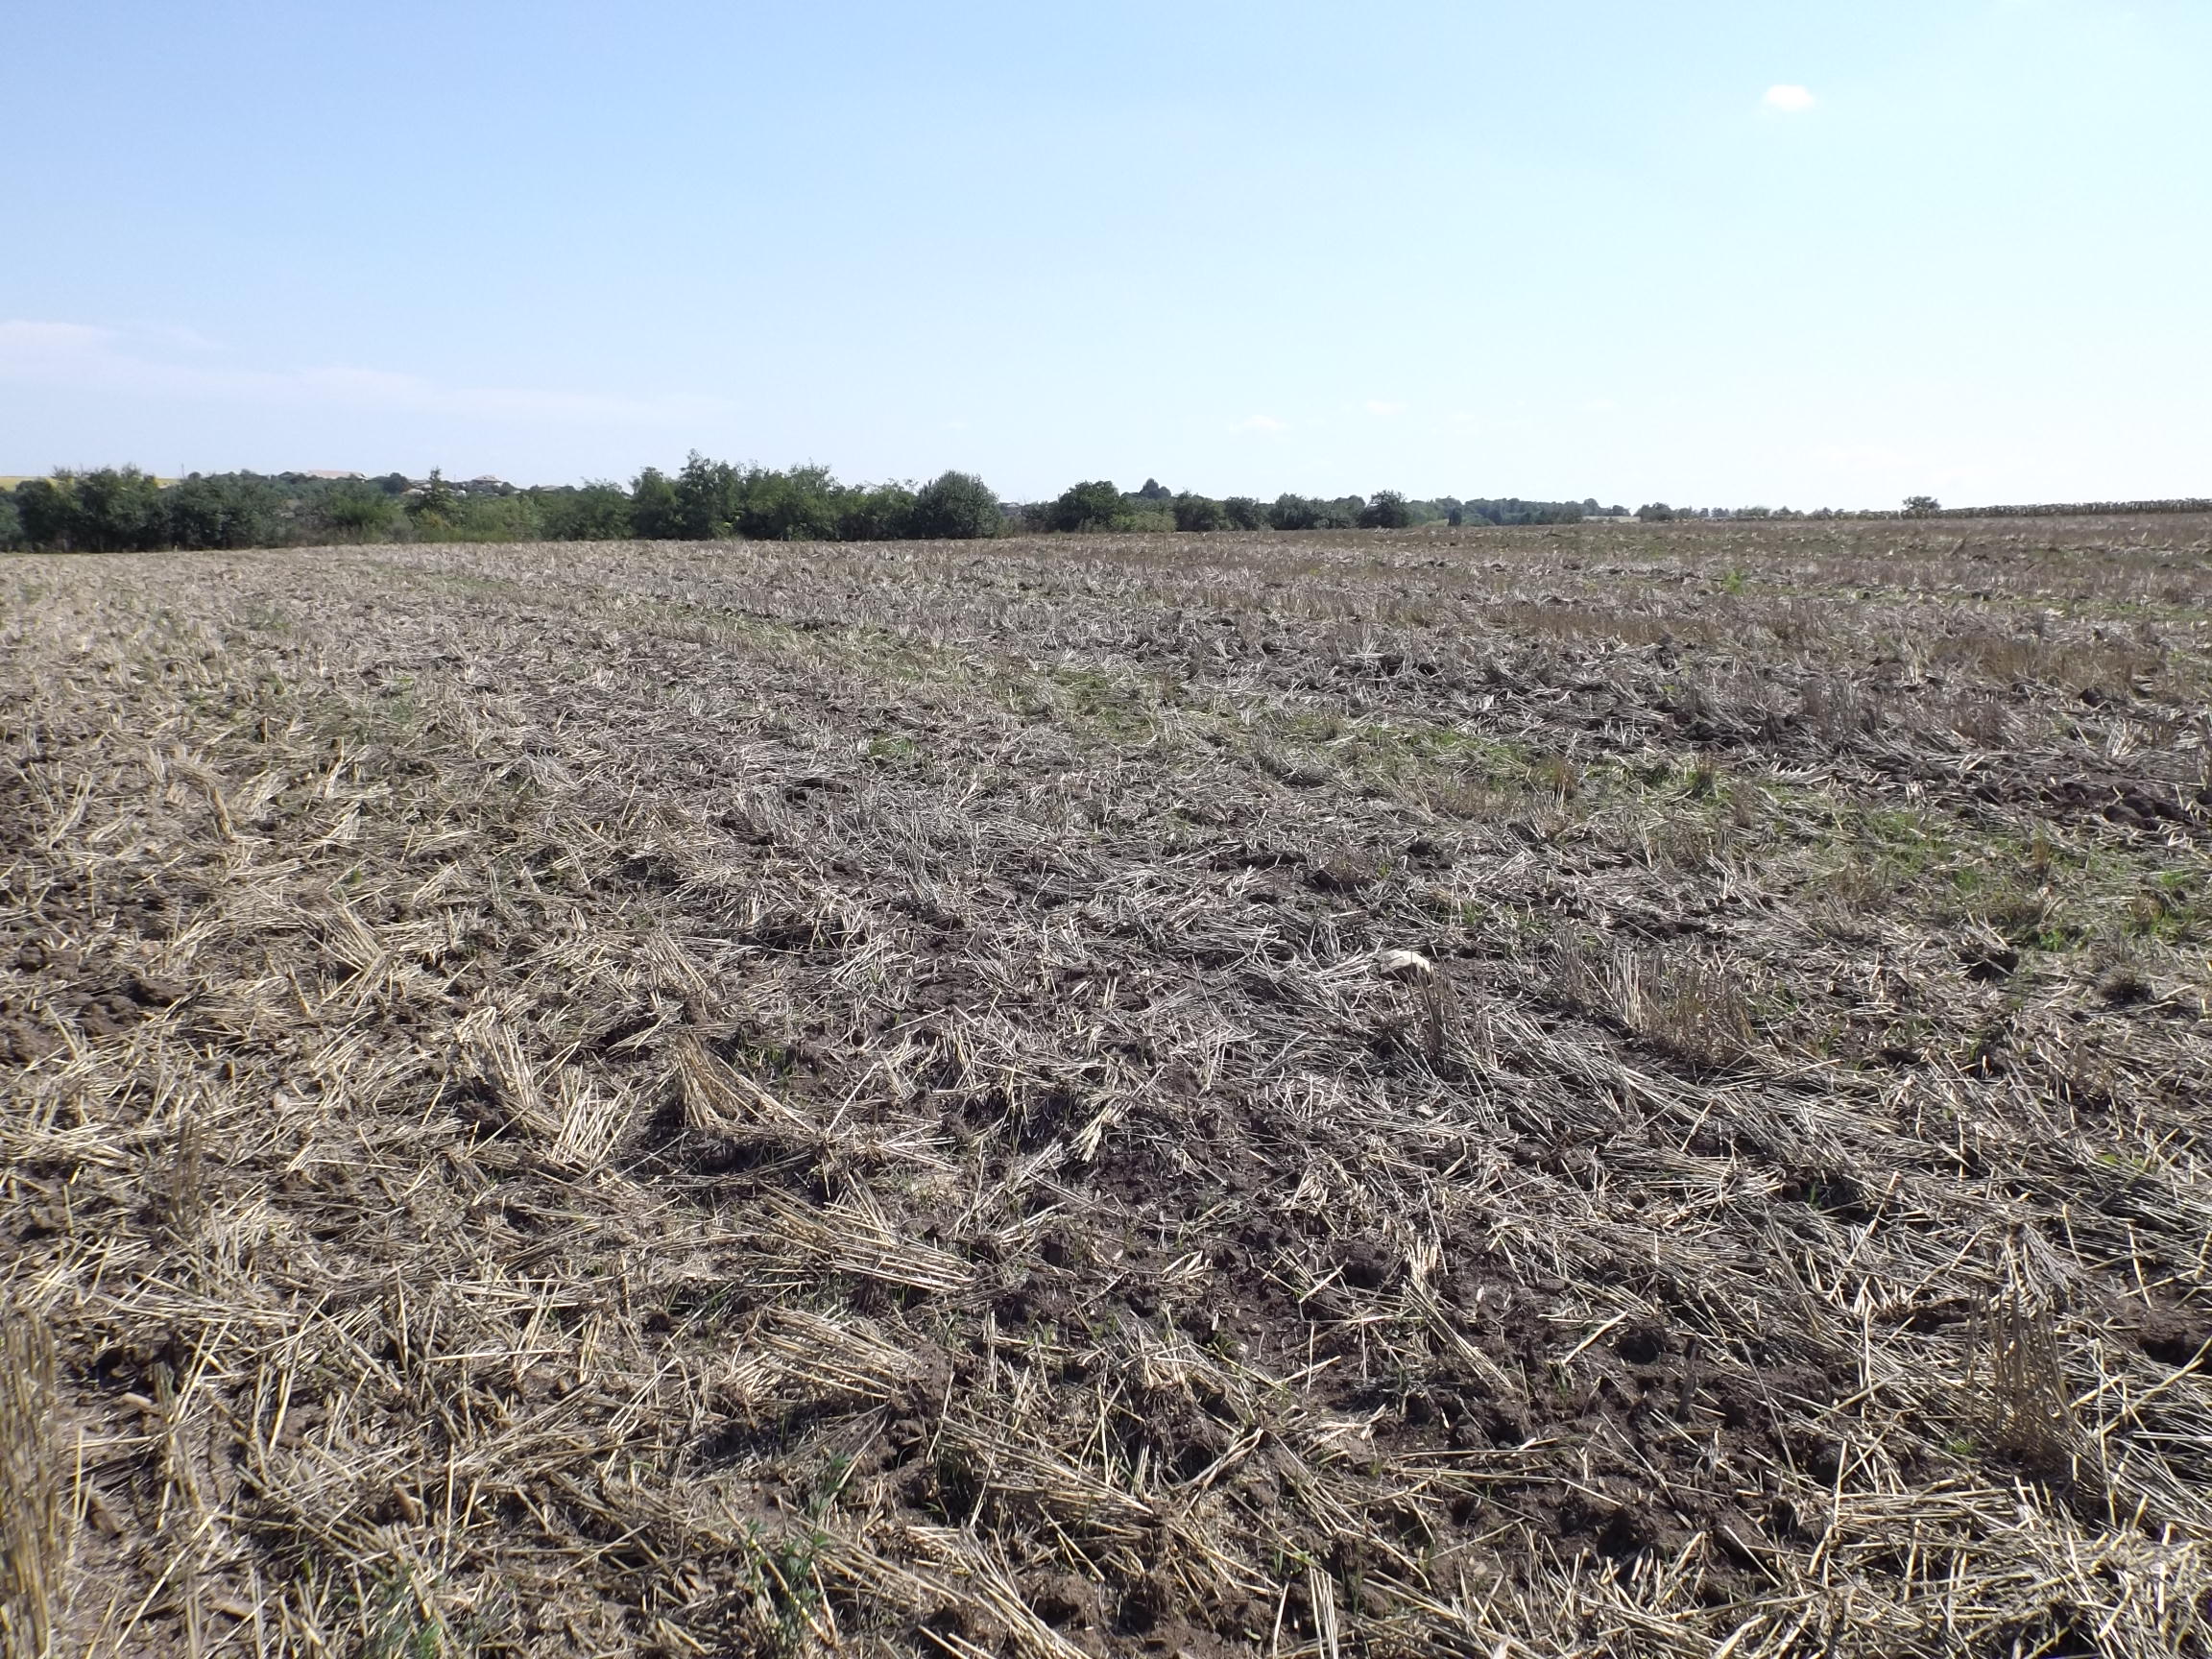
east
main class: Cropland
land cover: Common wheat
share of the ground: < 10 %
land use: Agriculture (excluding fallow land and kitchen gardens)
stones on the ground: < 10 %
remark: Harvested field
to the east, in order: Common wheat; Broadleaved woodland; Tracks; Grass margins; Fences; Vineyards; Grass margins; Fences; Lines of trees; Artificial constructions in urban areas
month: August
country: BG
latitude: 43.4398
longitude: 27.3874
